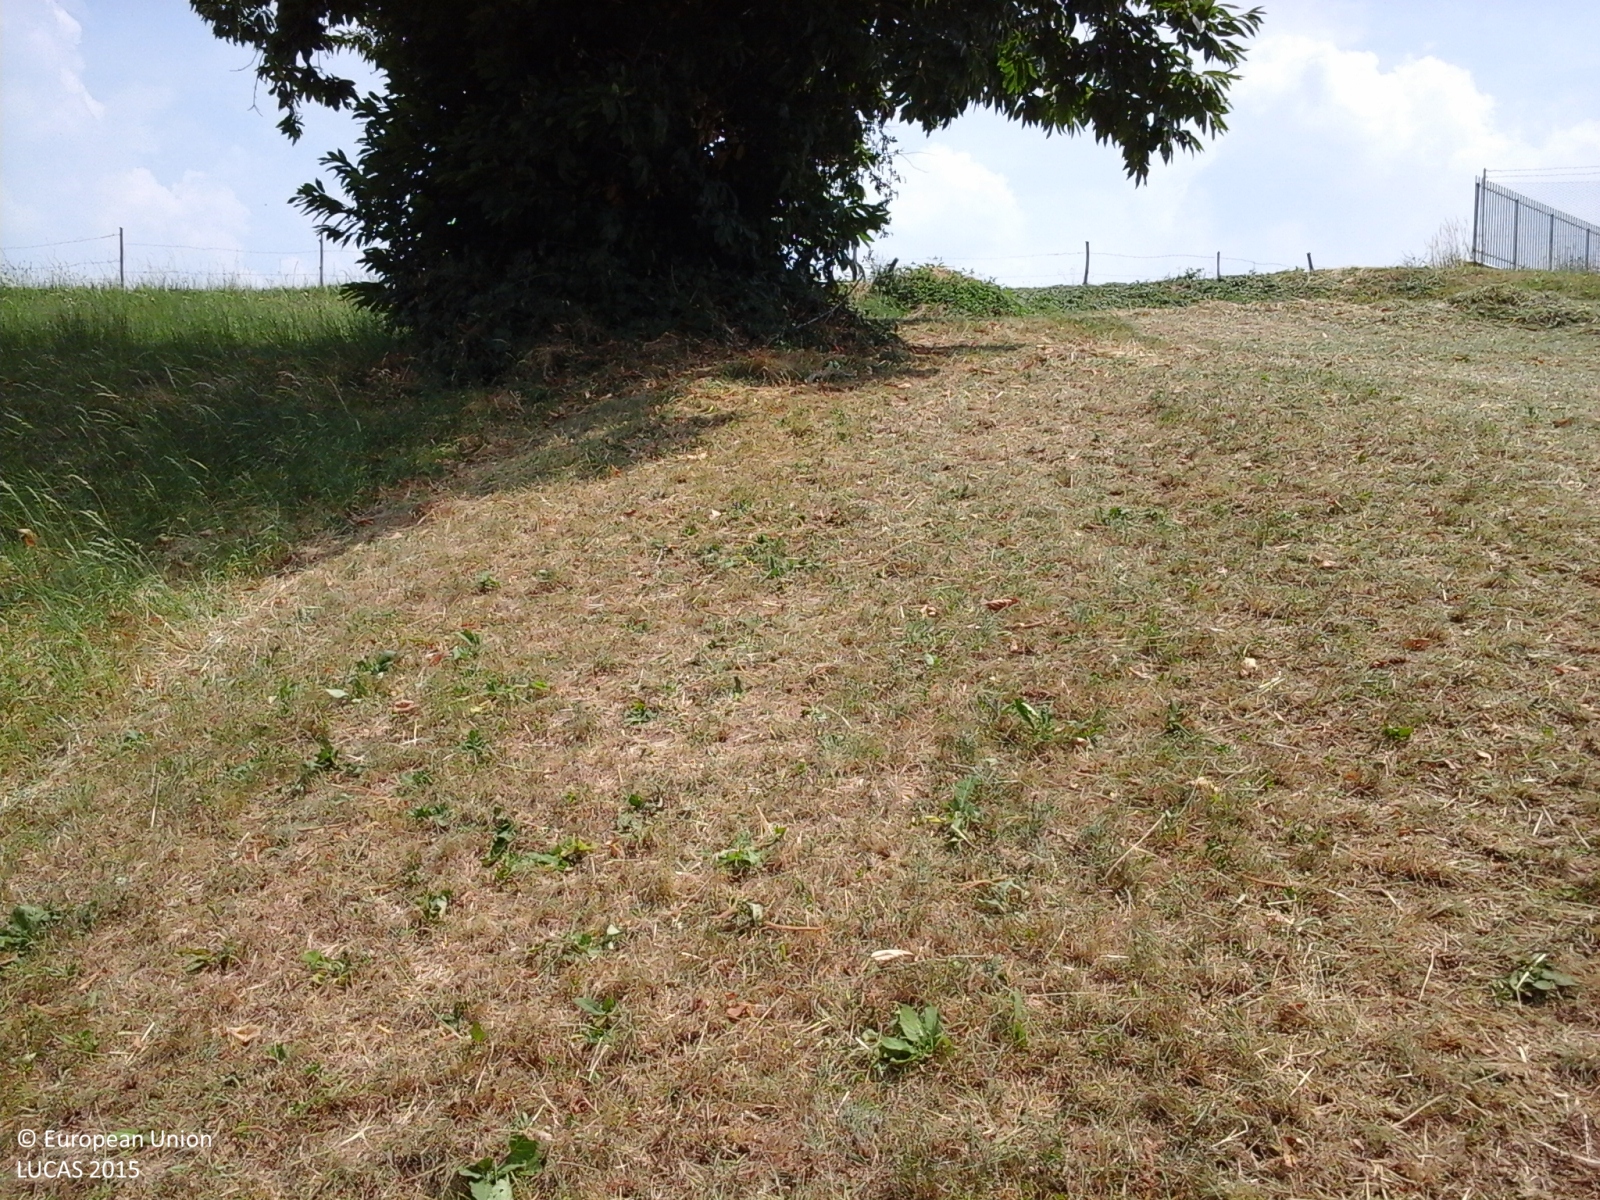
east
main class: Grassland
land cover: Grassland with sparse tree/shrub cover
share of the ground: > 75 %
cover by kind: herbaceous plants 85 %, shrubs 10 %, broadleaved forest trees 5 %
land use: Agriculture (excluding fallow land and kitchen gardens)
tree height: > 5 m
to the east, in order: Grassland with sparse tree/shrub cover; Paved roads, cycling and walking lanes; Fences; Grassland without tree/shrub cover; Artificial constructions in urban areas
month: July
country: IT
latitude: 45.5894
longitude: 11.0366
